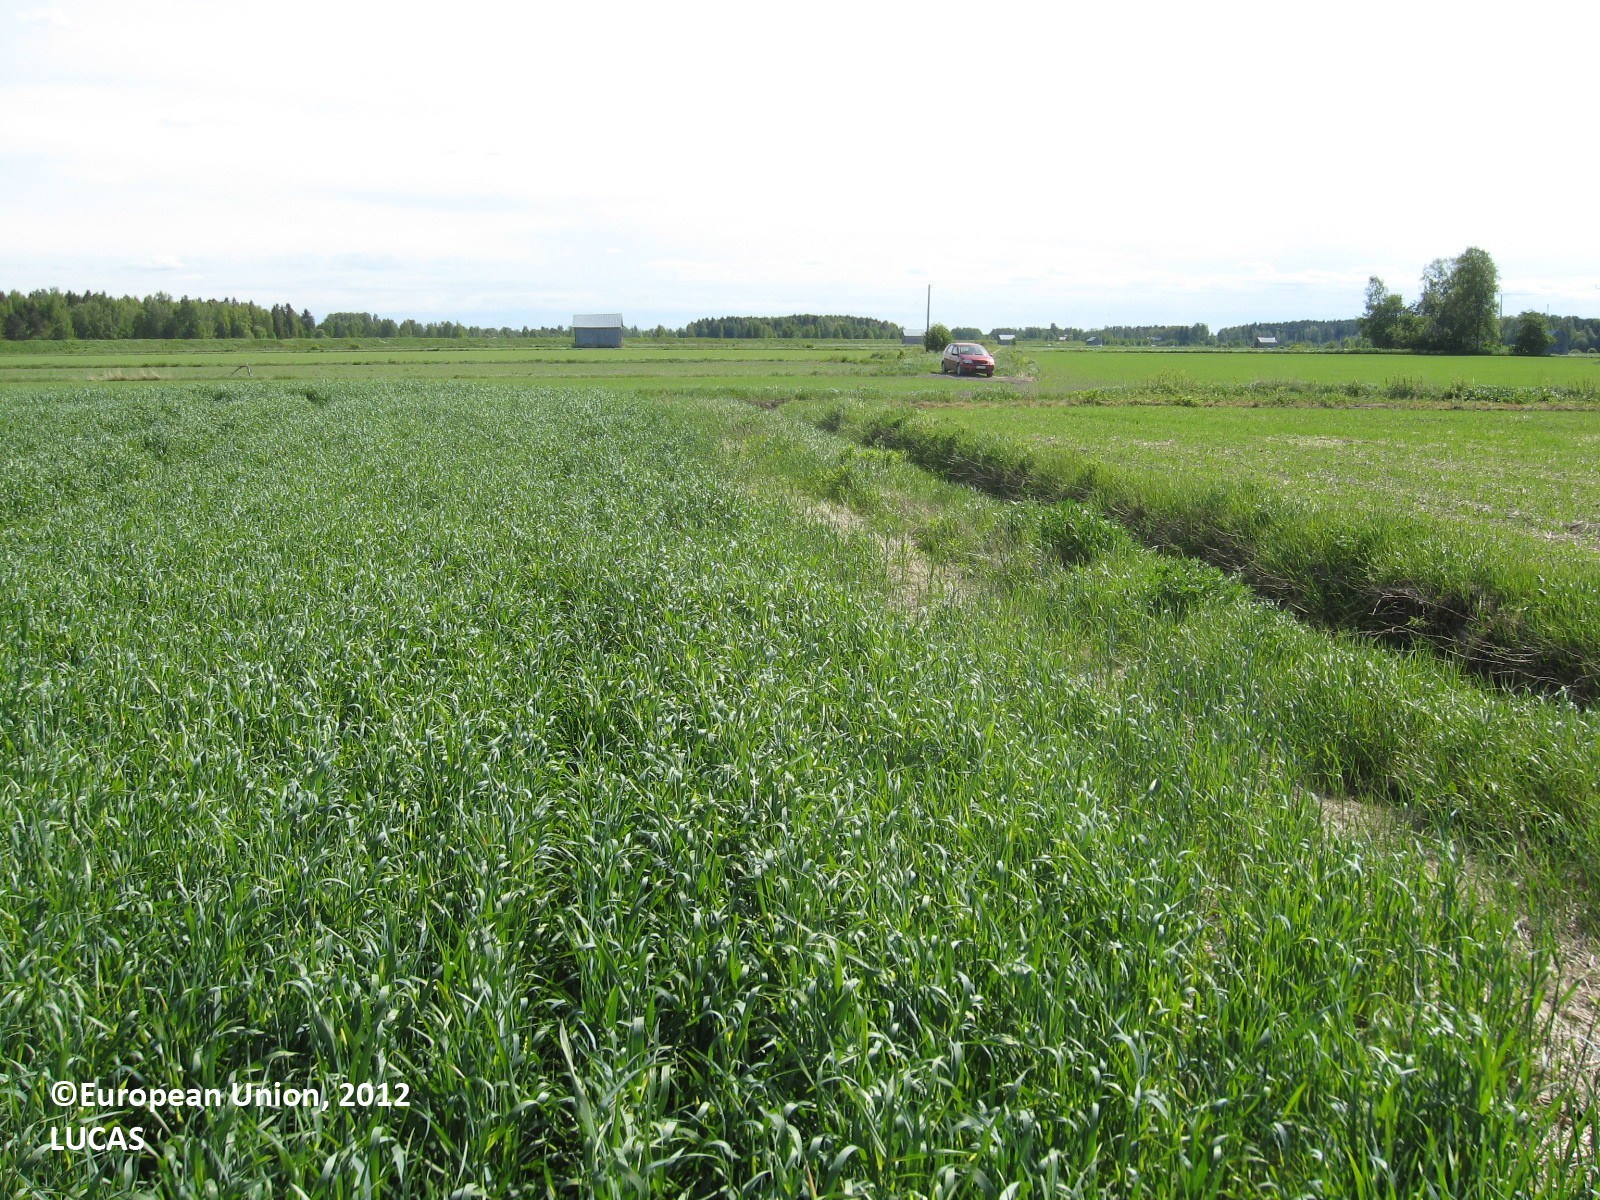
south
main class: Cropland
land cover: Rye
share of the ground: > 75 %
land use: Agriculture (excluding fallow land and kitchen gardens)
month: June
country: FI
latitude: 63.1833
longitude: 21.8637
